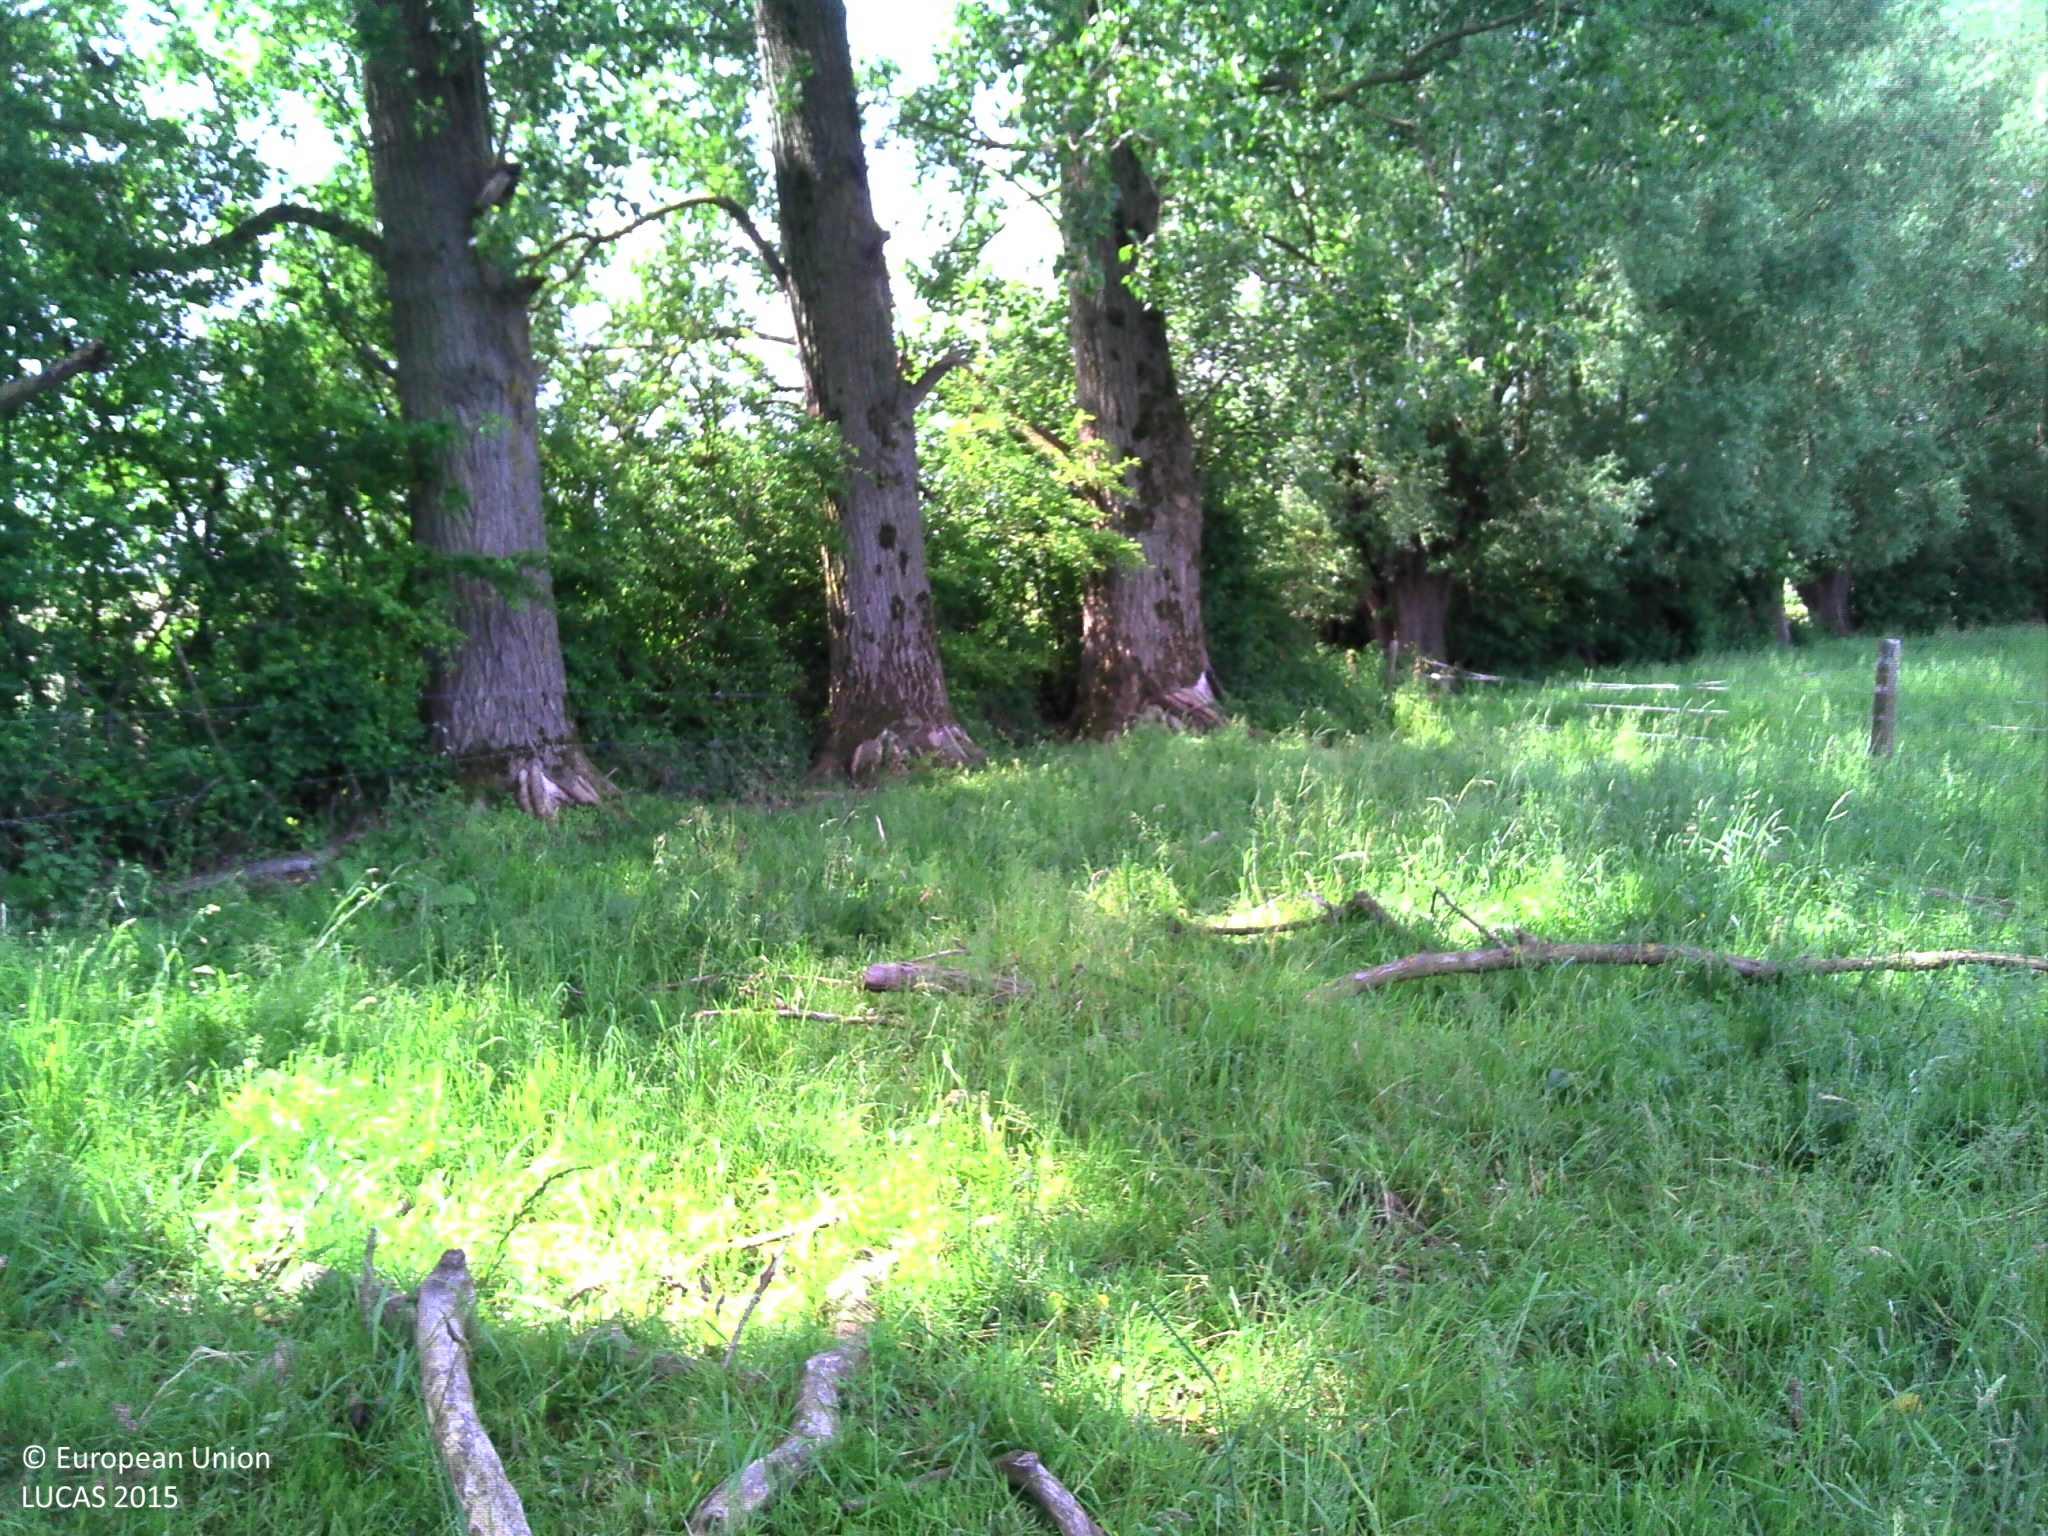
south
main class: Grassland
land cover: Grassland without tree/shrub cover
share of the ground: > 75 %
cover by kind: herbaceous plants 100 %
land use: Agriculture (excluding fallow land and kitchen gardens)
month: June
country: BE
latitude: 50.9236
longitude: 3.9192
